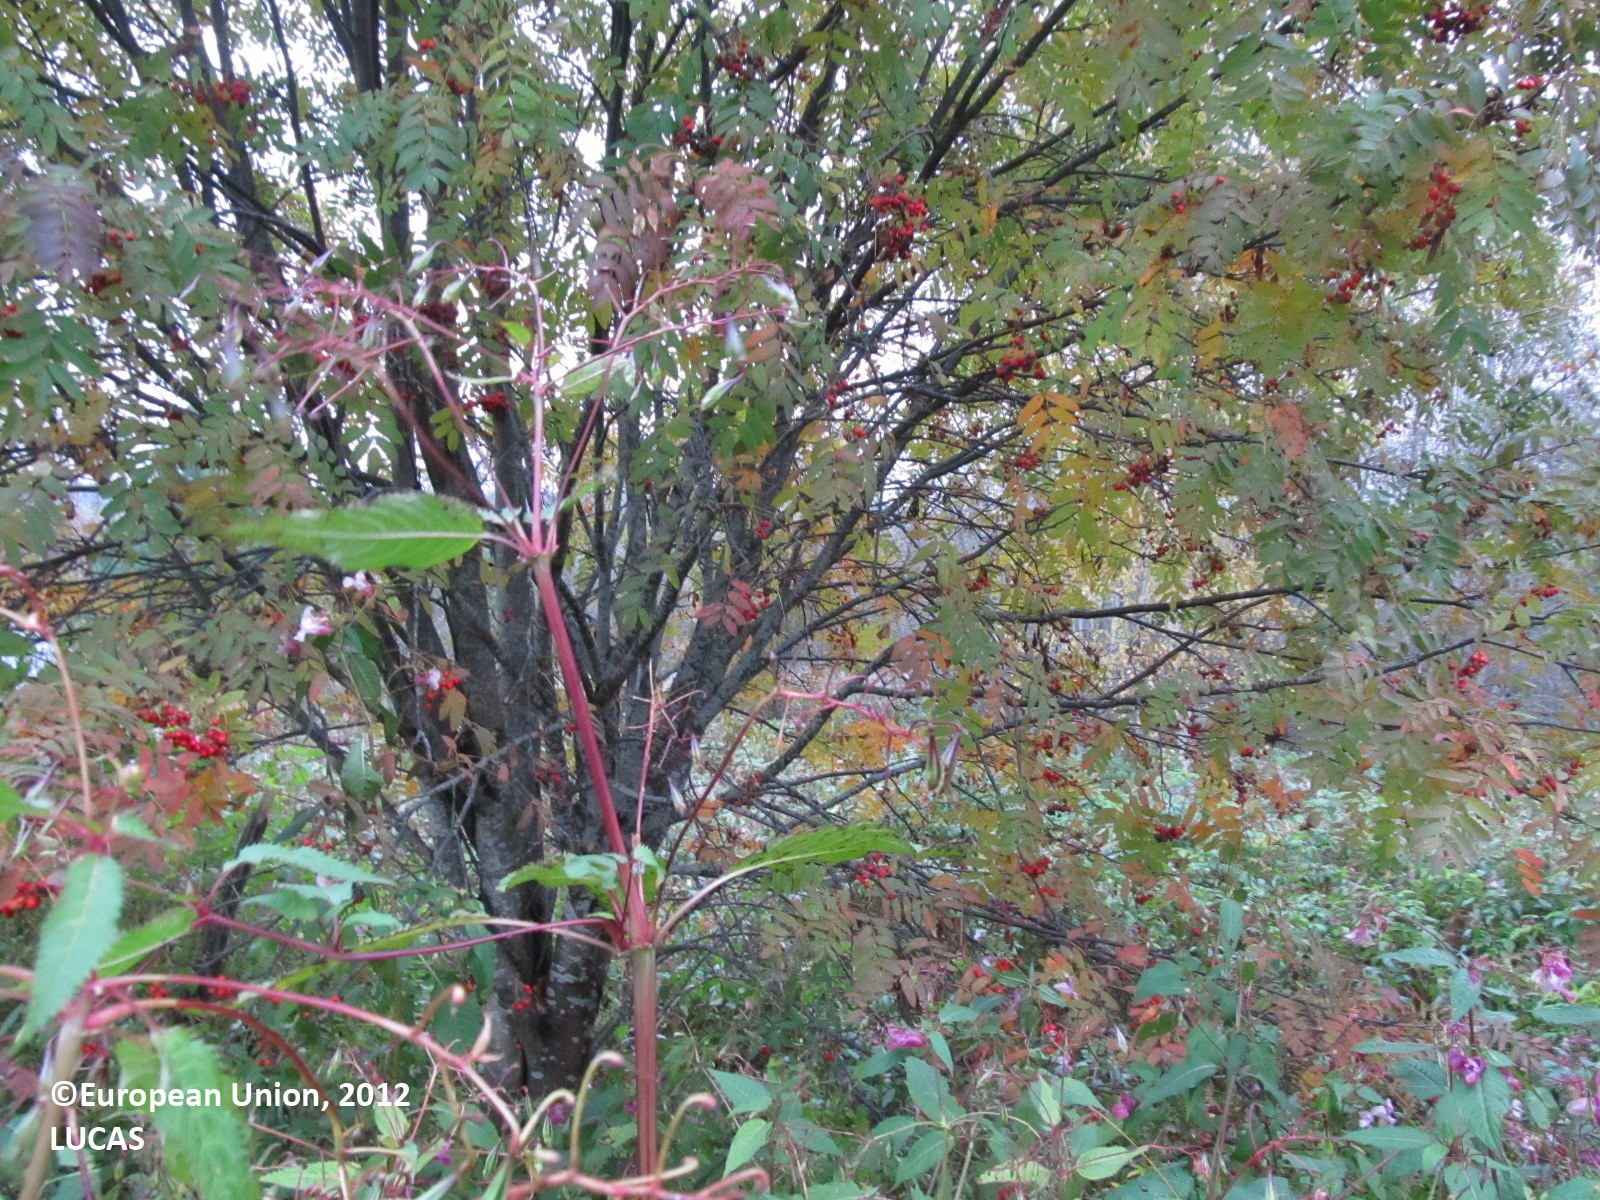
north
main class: Shrubland
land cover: Shrubland with sparse tree cover
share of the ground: > 75 %
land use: Semi-natural and natural areas not in use
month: September
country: FI
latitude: 62.2600
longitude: 28.1197
